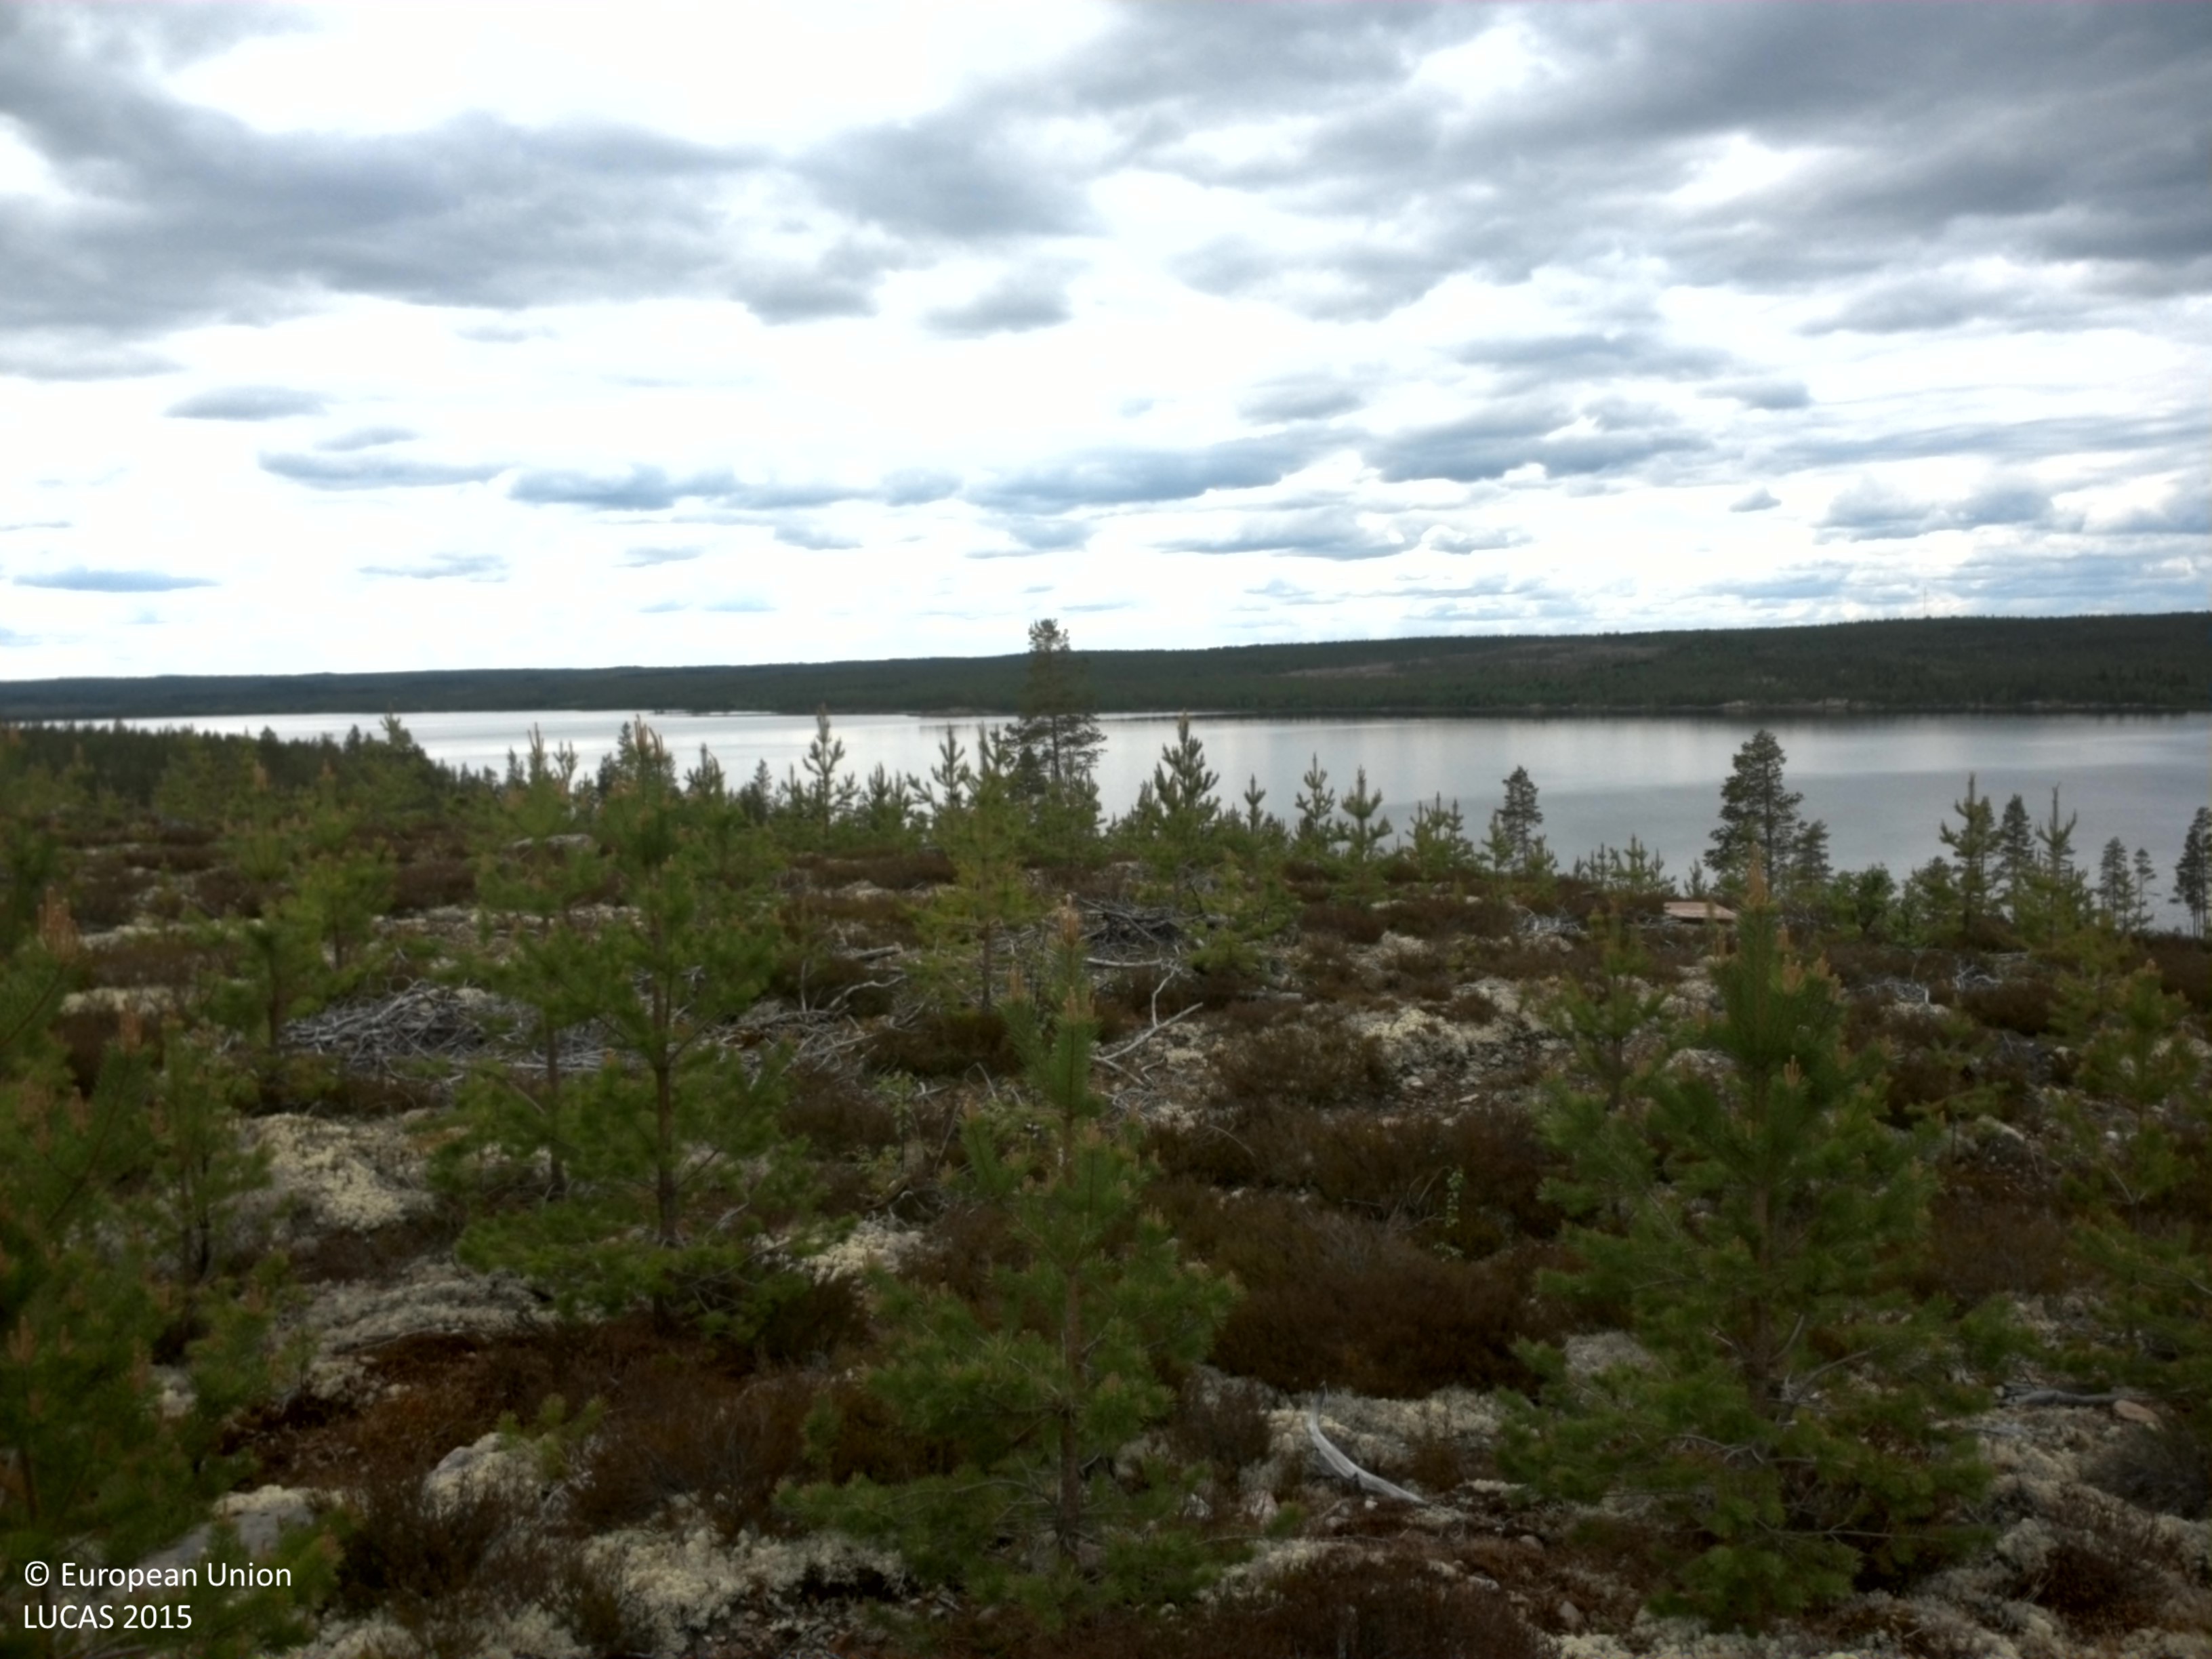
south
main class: Woodland
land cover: Pine dominated coniferous woodland
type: boreal forest
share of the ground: 10 - 25 %
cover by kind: lichens and mosses 30 %, coniferous forest trees 25 %, consolidated bare surface 20 %, shrubs 15 %, herbaceous plants 10 %
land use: Forestry
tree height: < 5 m
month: June
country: SE
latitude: 61.5638
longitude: 13.3948
